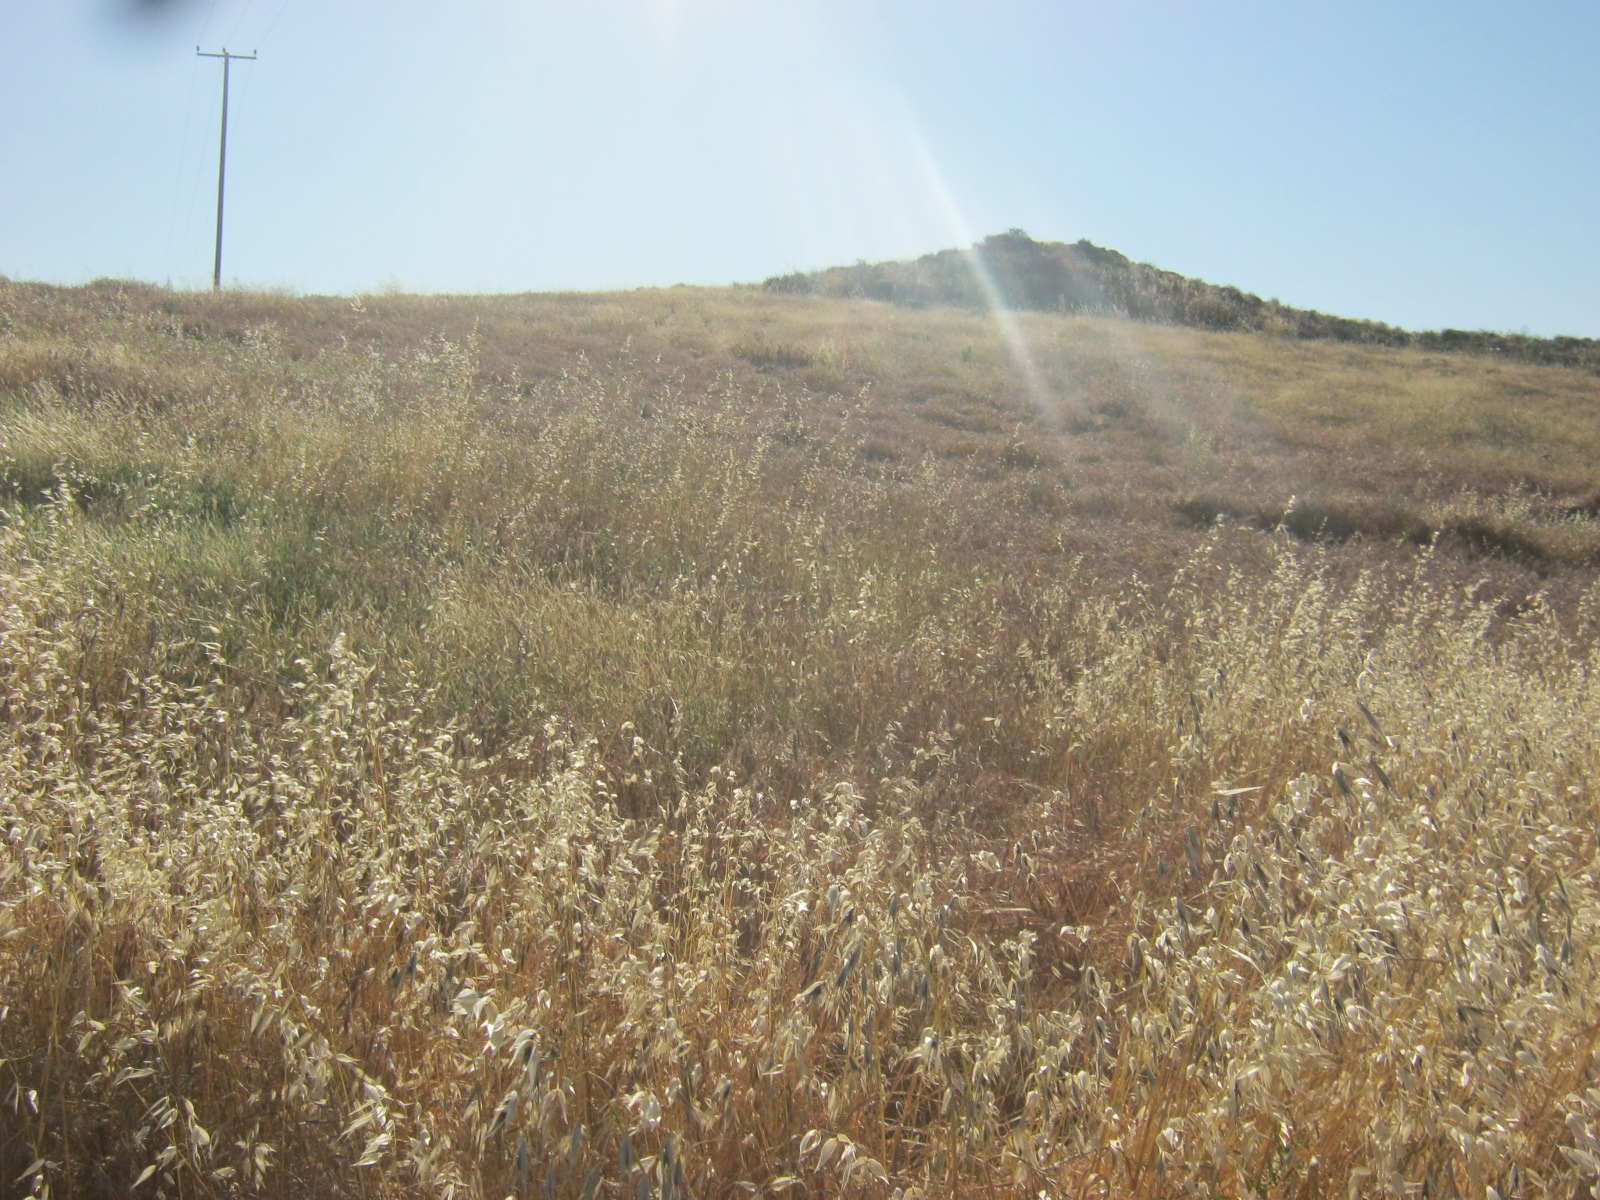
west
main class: Grassland
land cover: Spontaneously vegetated surfaces
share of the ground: > 75 %
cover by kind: herbaceous plants 95 %, unconsolidated bare surface 5 %
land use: Semi-natural and natural areas not in use
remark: Temporary dry
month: May
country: CY
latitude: 35.0563
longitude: 33.2204
